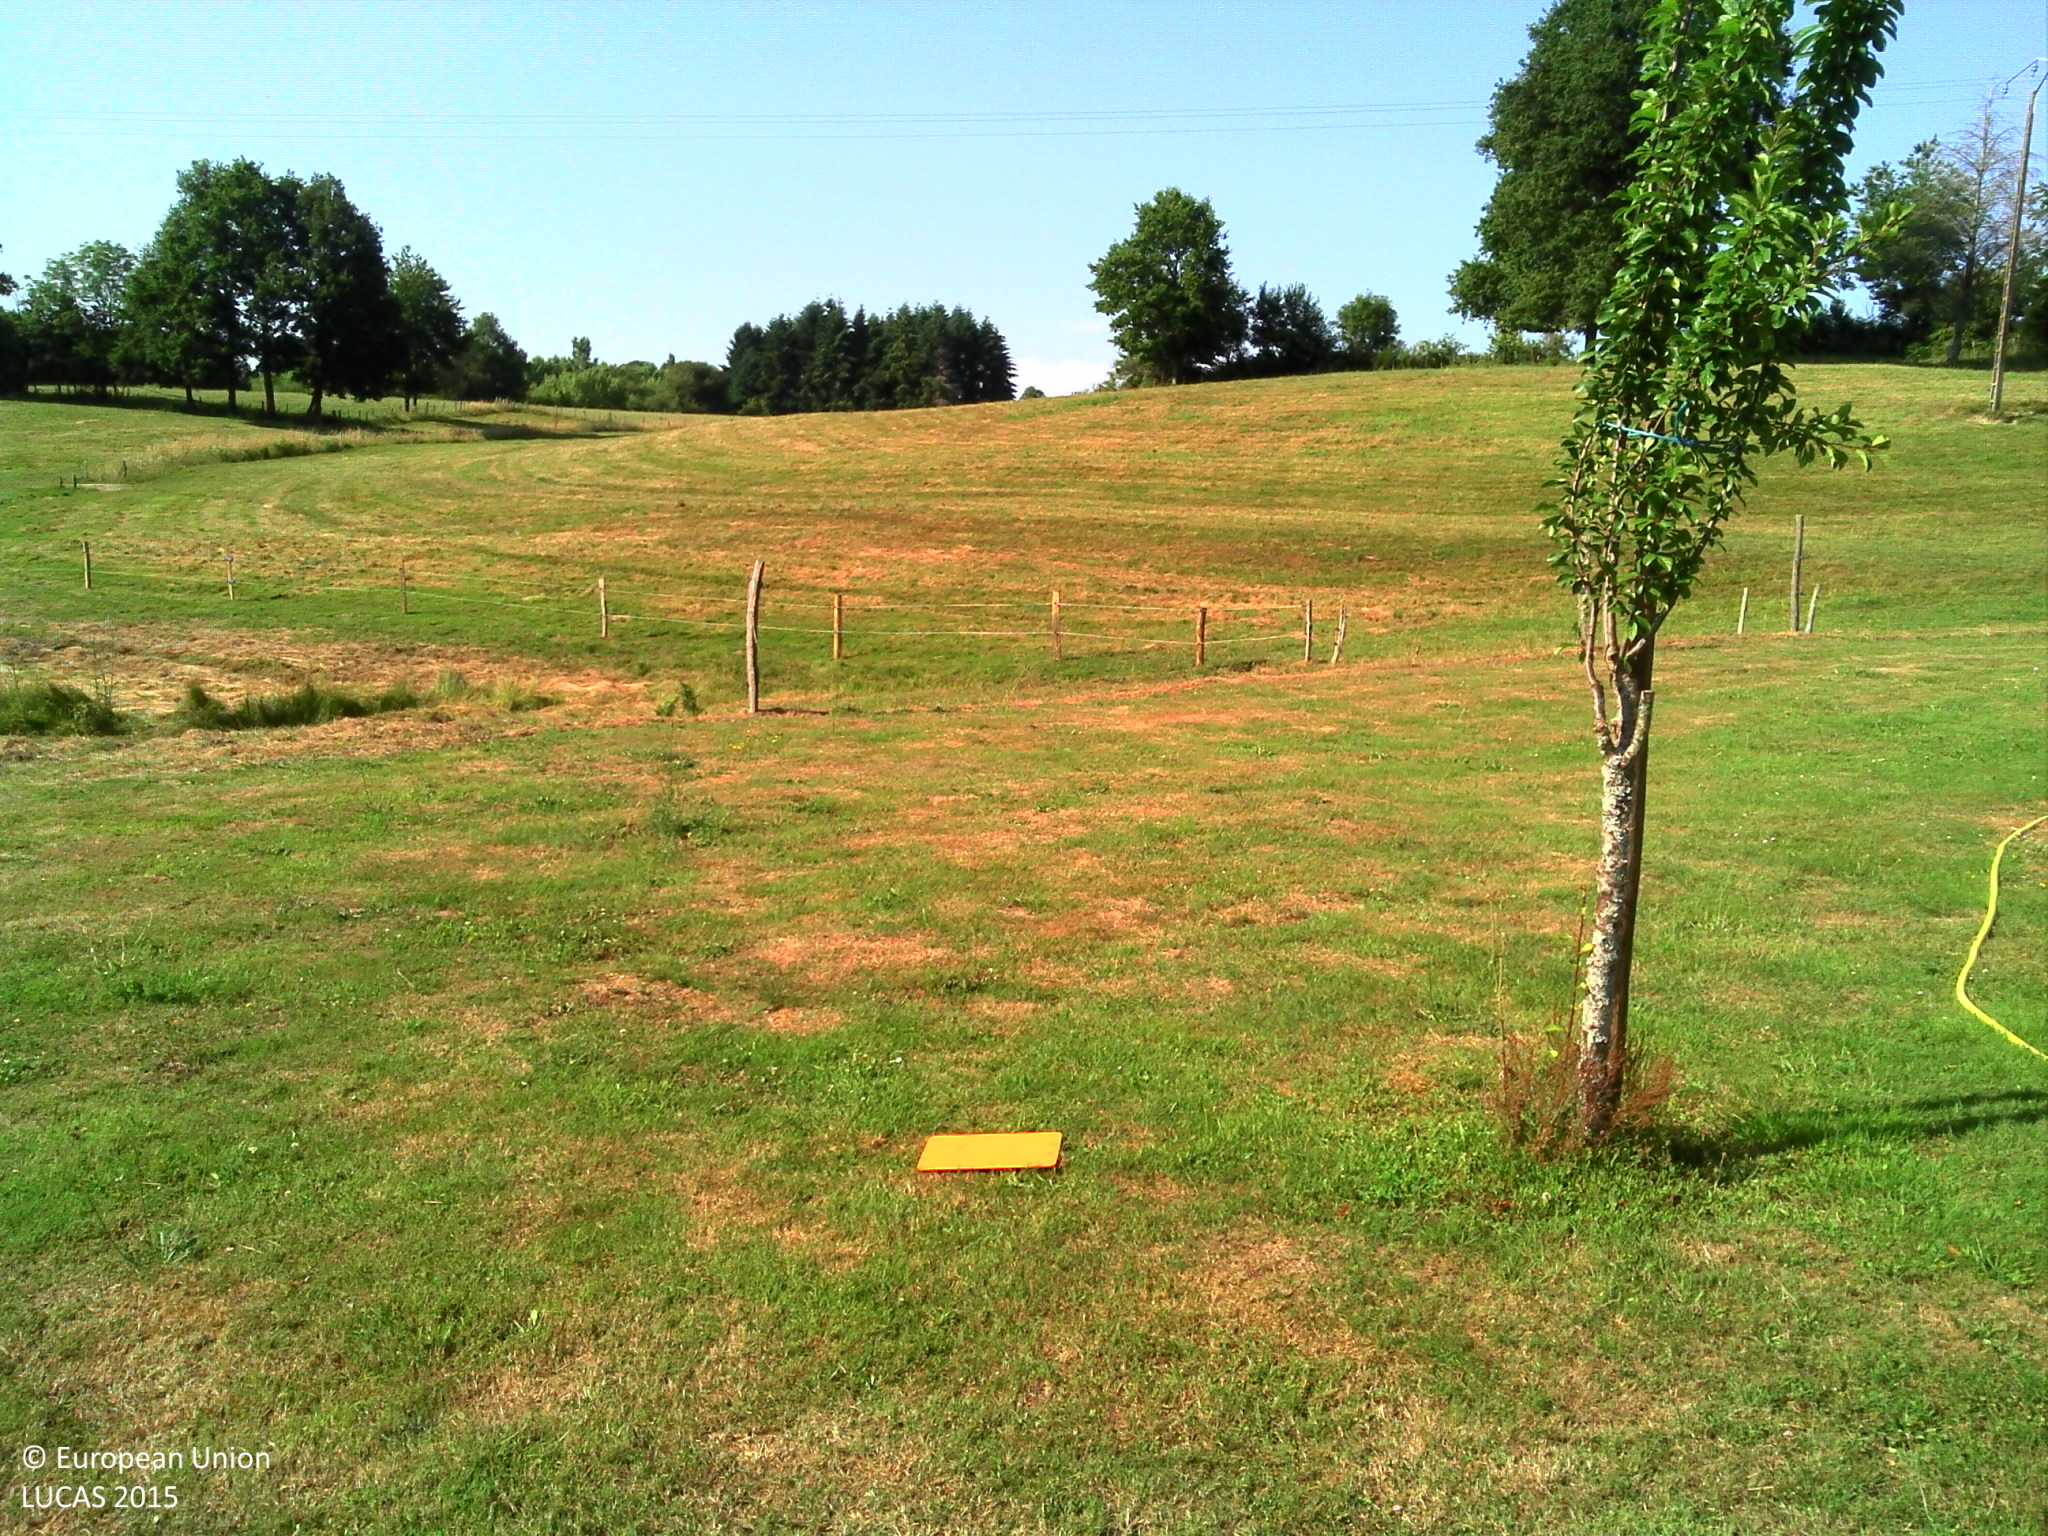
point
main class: Grassland
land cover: Grassland with sparse tree/shrub cover
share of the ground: > 75 %
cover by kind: herbaceous plants 95 %, broadleaved forest trees 5 %
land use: Residential
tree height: > 5 m
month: June
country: FR
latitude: 45.7363
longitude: 0.5922
